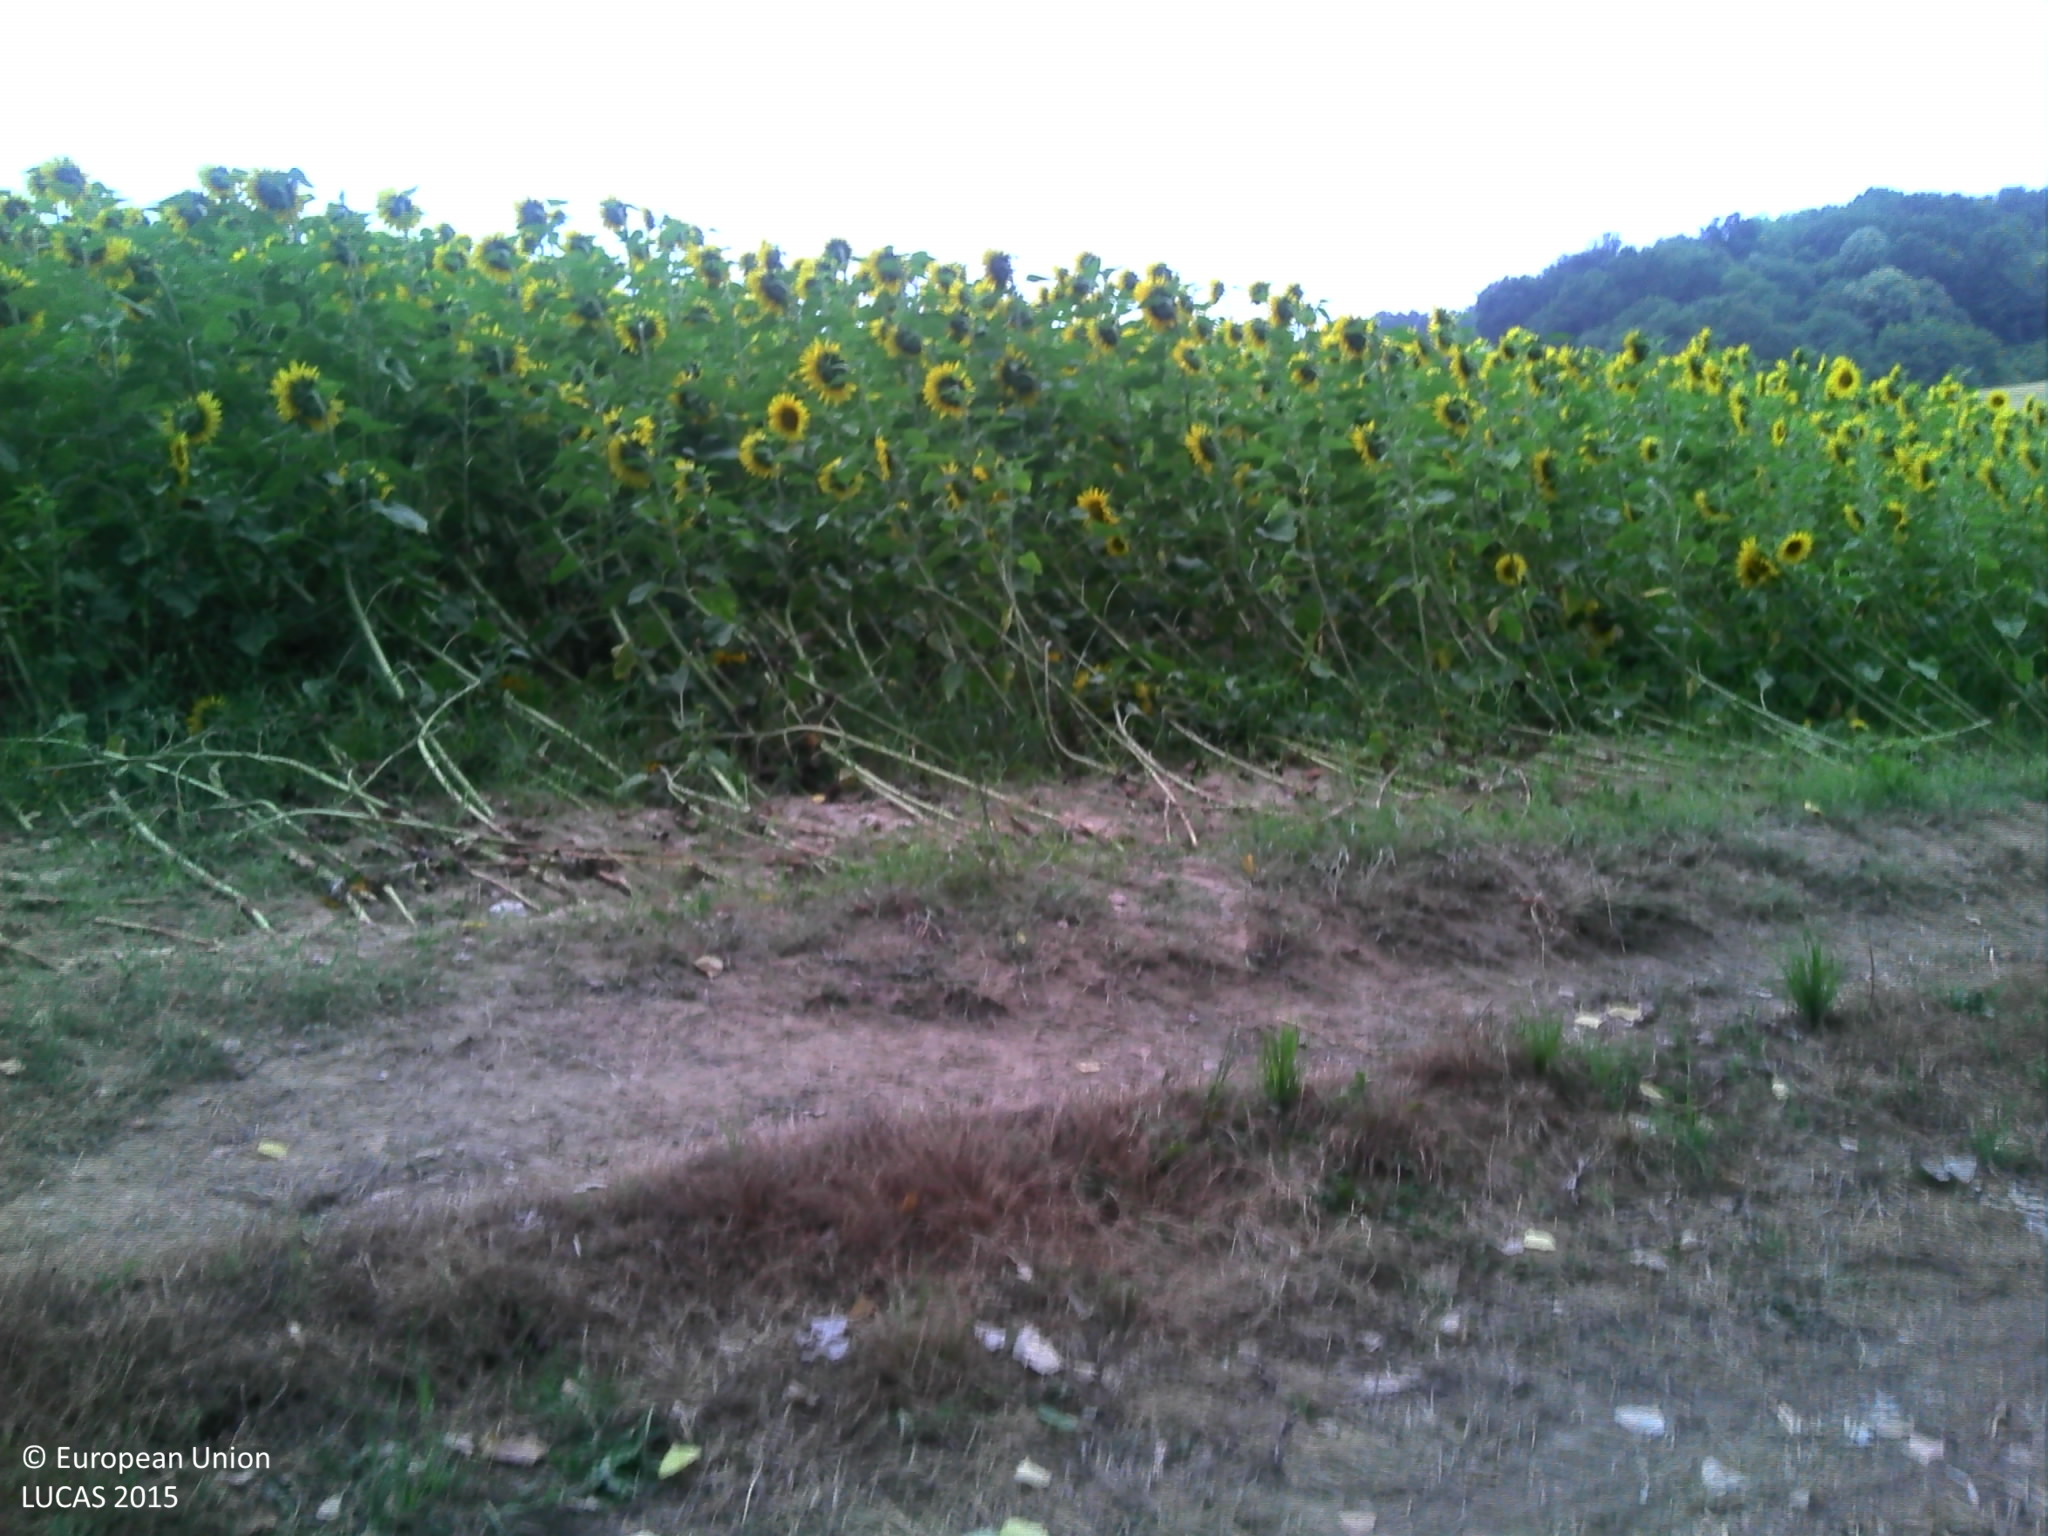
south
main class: Woodland
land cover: Broadleaved woodland
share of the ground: > 75 %
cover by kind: broadleaved forest trees 65 %, herbaceous plants 30 %, consolidated bare surface 5 %
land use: Residential
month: July
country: FR
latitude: 43.6822
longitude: -0.5676
